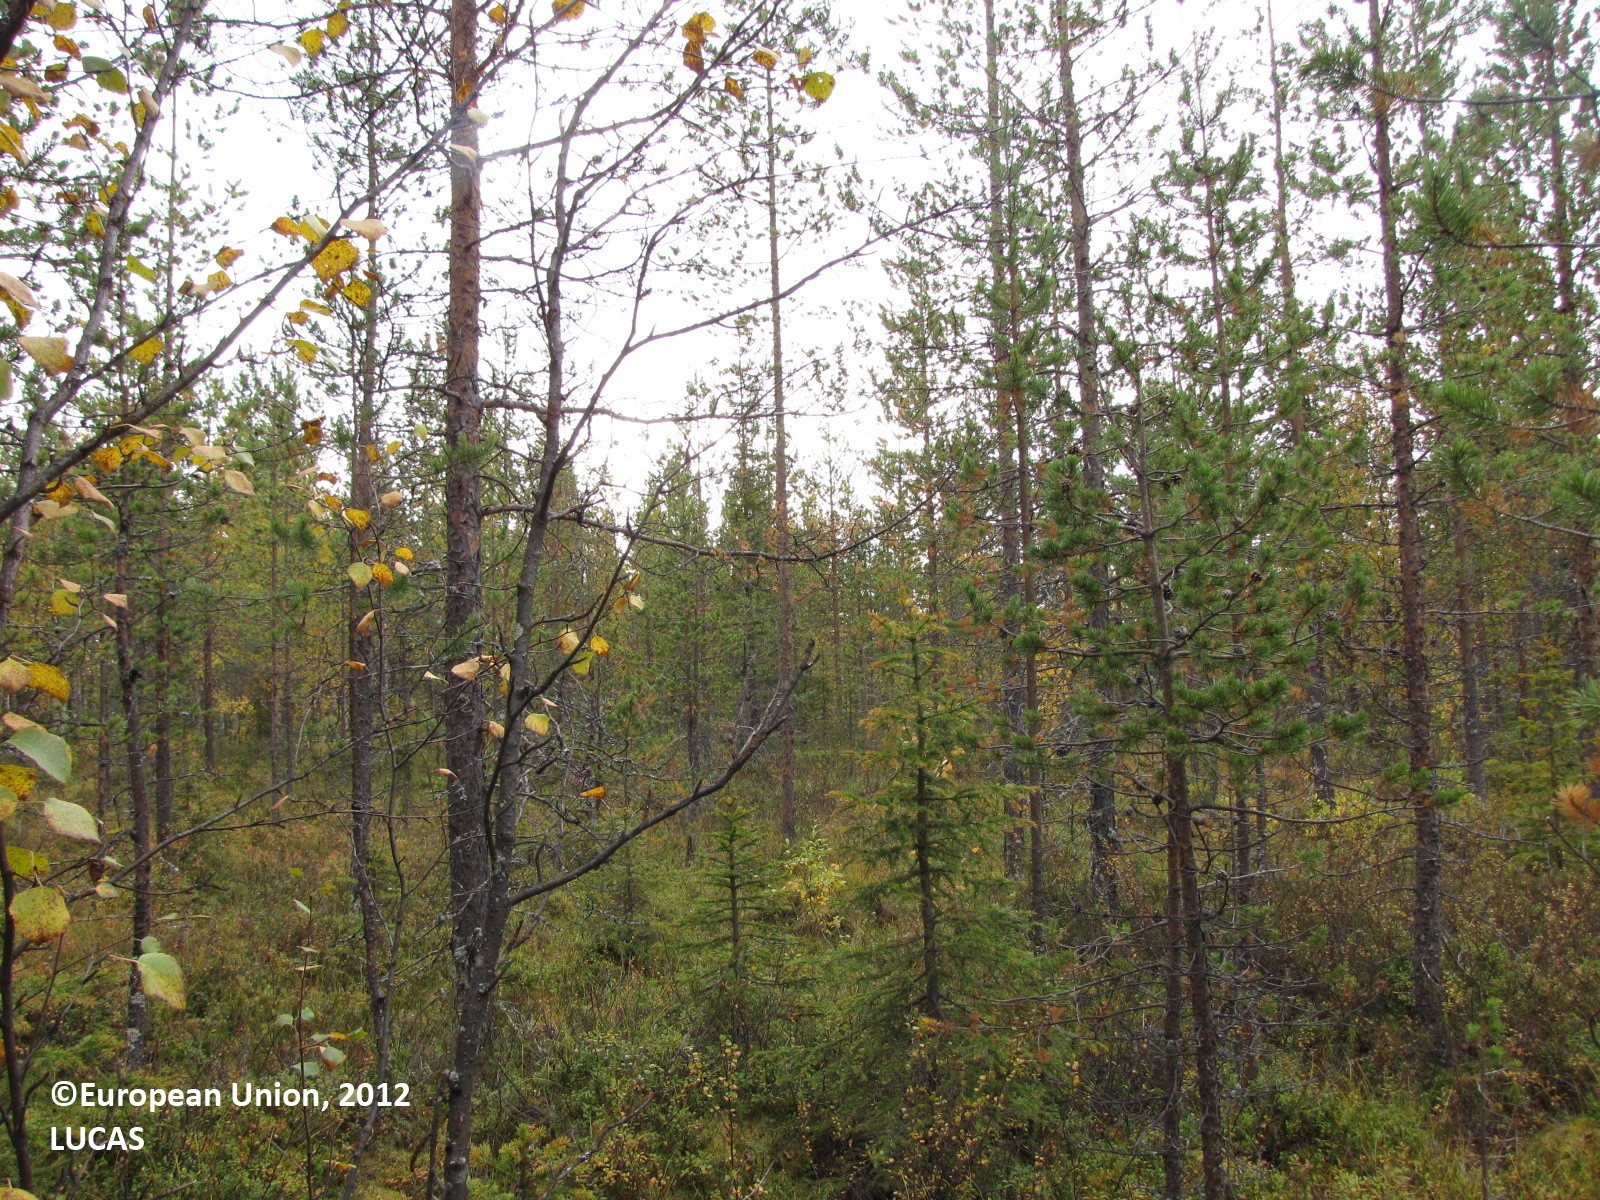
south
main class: Woodland
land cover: Pine dominated mixed woodland
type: boreal forest
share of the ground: 25 - 50 %
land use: Forestry
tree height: > 5 m
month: September
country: FI
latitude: 67.3572
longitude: 23.9198
